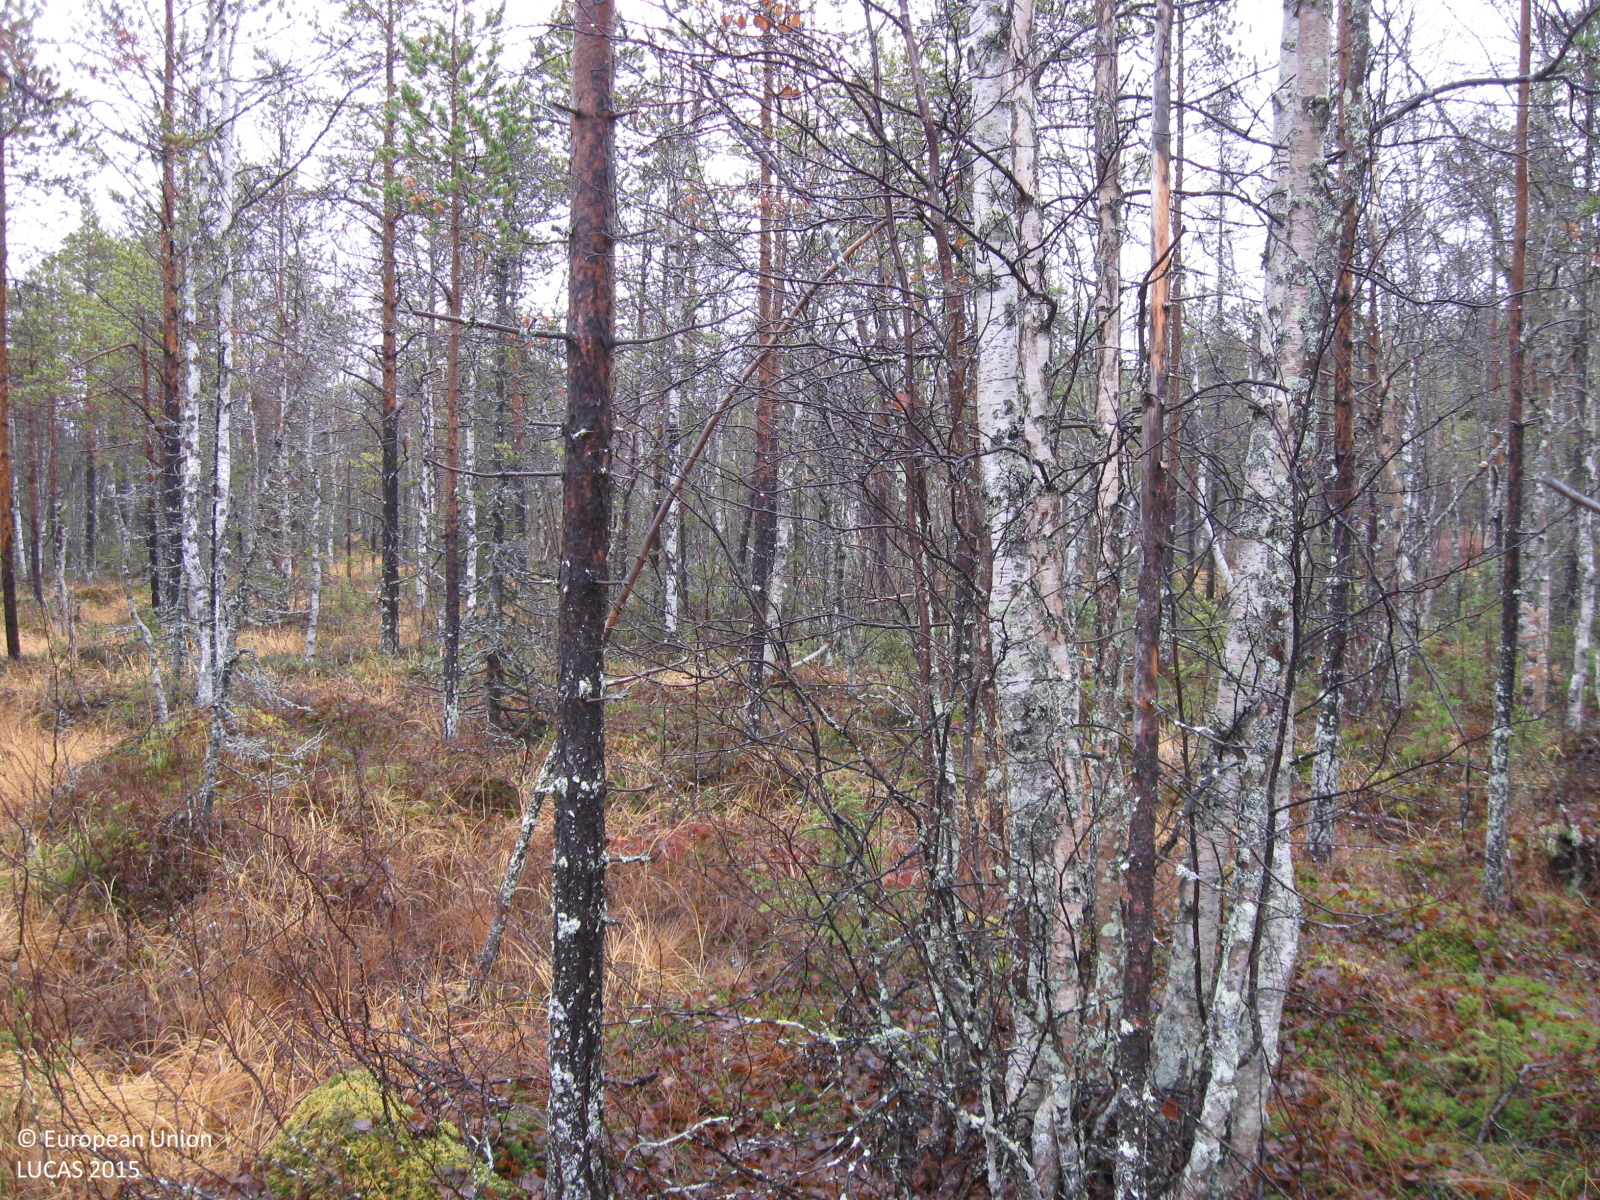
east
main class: Woodland
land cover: Pine dominated mixed woodland
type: mire and swamp forests
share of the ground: 50 - 75 %
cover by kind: coniferous forest trees 40 %, shrubs 25 %, broadleaved forest trees 20 %, herbaceous plants 10 %, lichens and mosses 5 %
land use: Forestry
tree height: > 5 m
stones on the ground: < 10 %
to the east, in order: Pine dominated mixed woodland; Ditches and canals; Spruce dominated mixed woodland; Peatbogs; Pine dominated mixed woodland; Shrubland with sparse tree cover; Broadleaved woodland
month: October
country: SE
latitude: 66.5738
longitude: 21.0258
